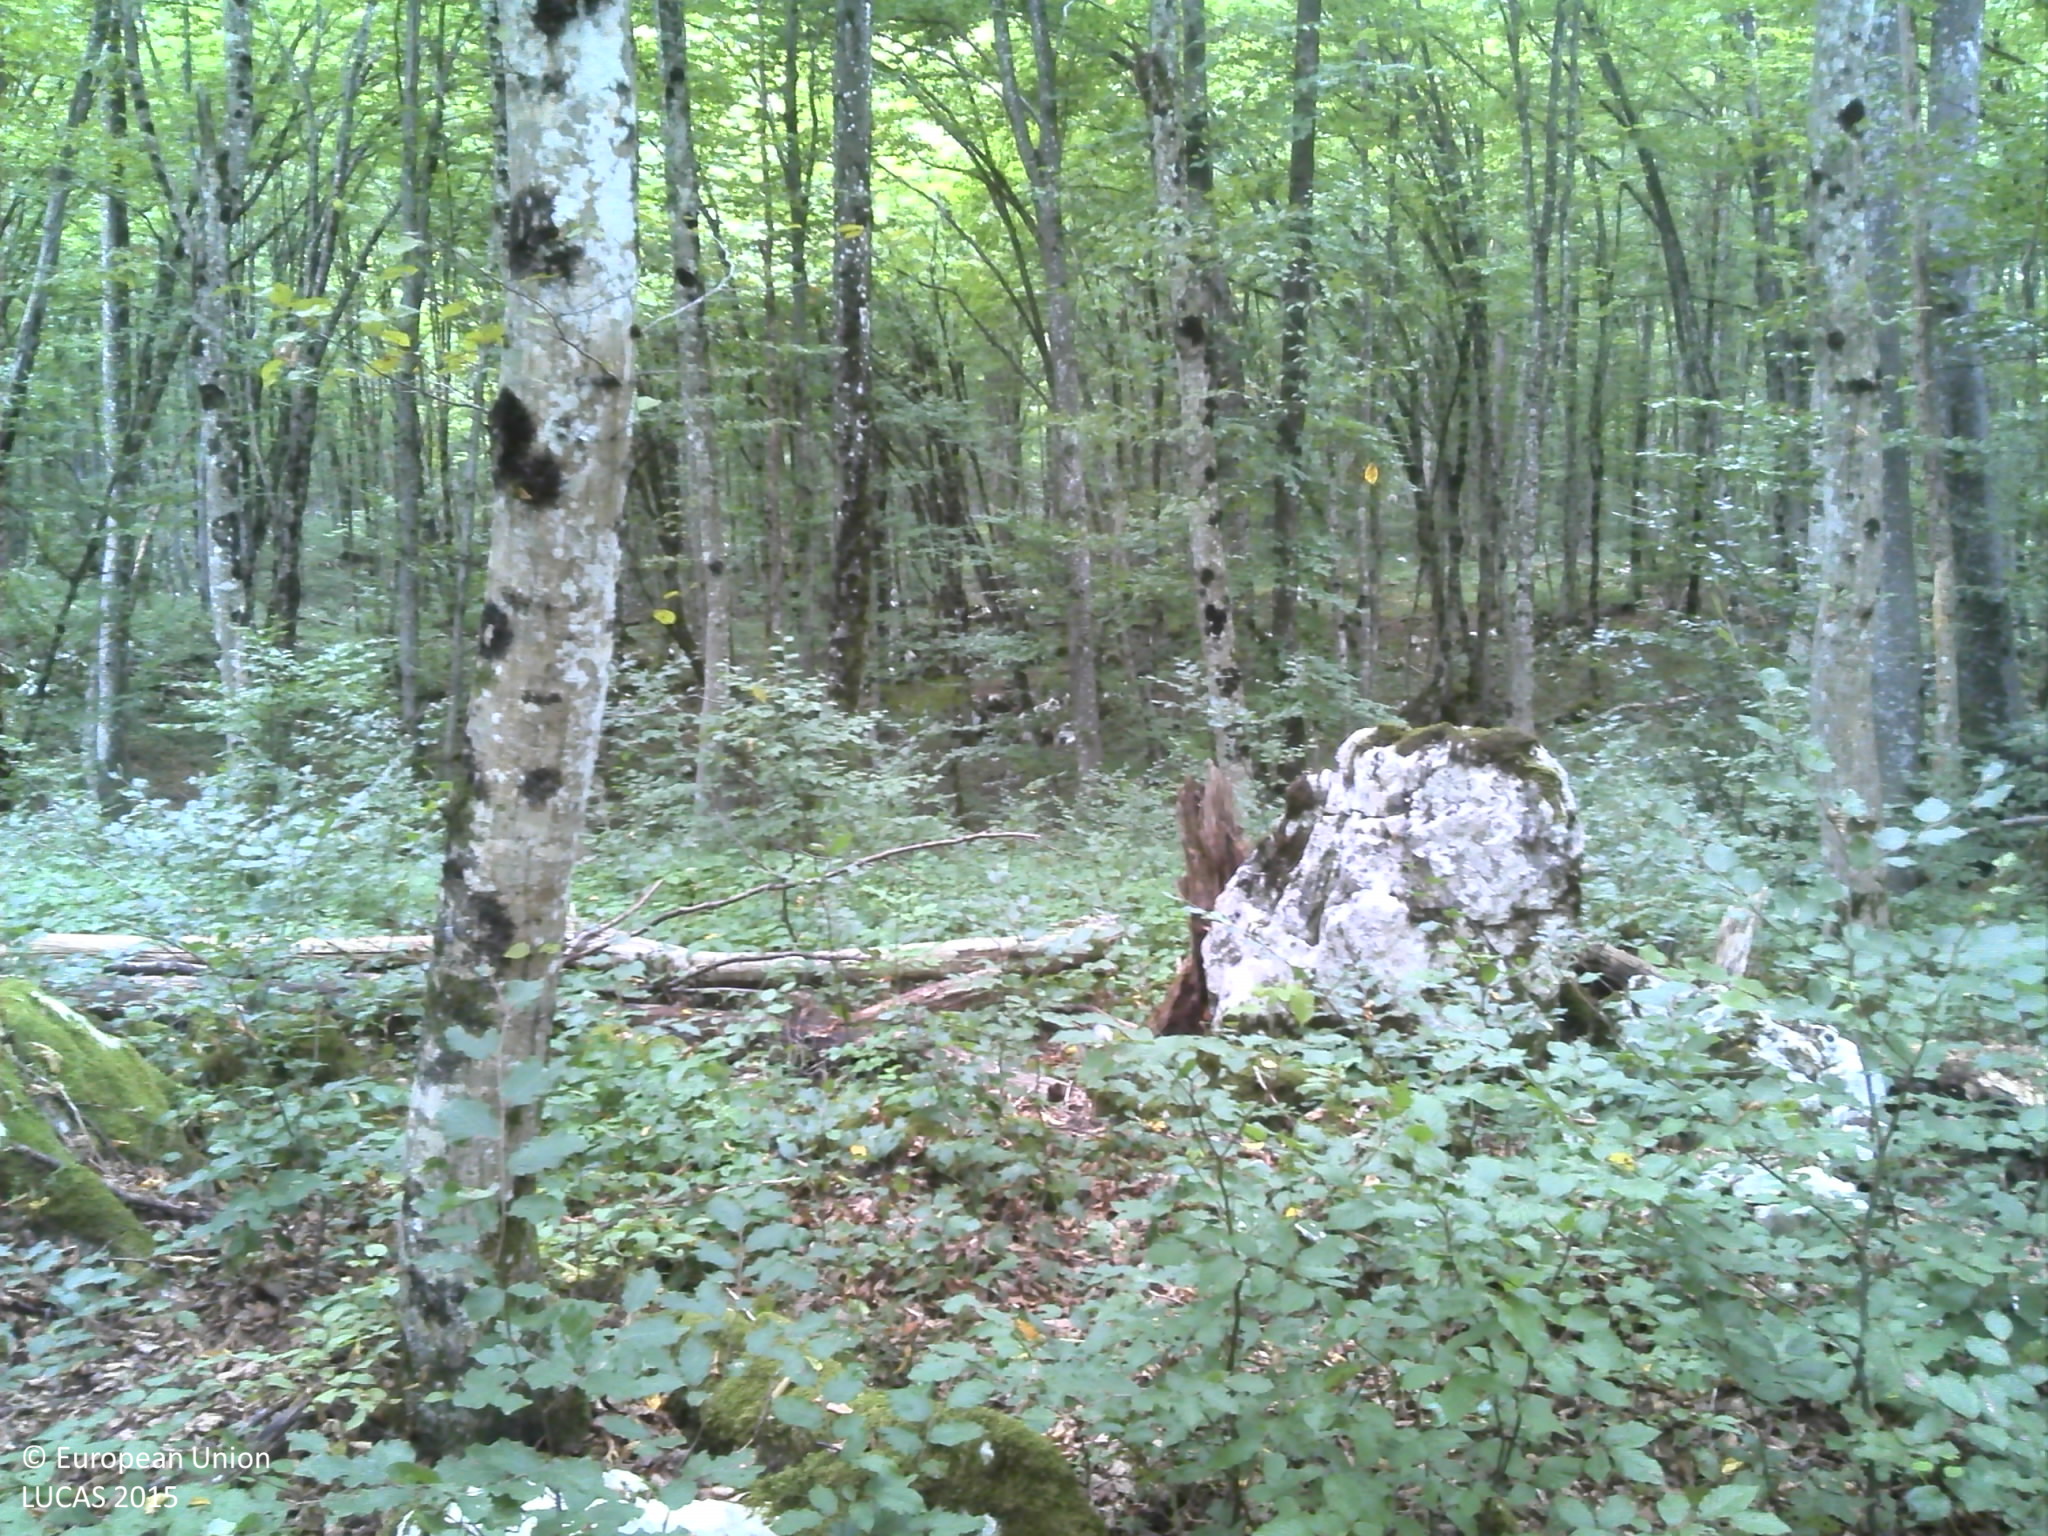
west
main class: Woodland
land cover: Broadleaved woodland
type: acidophilous oak and oak-birch forest
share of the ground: > 75 %
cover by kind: broadleaved forest trees 100 %
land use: Forestry
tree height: > 5 m
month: September
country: HR
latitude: 45.4101
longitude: 15.2471
